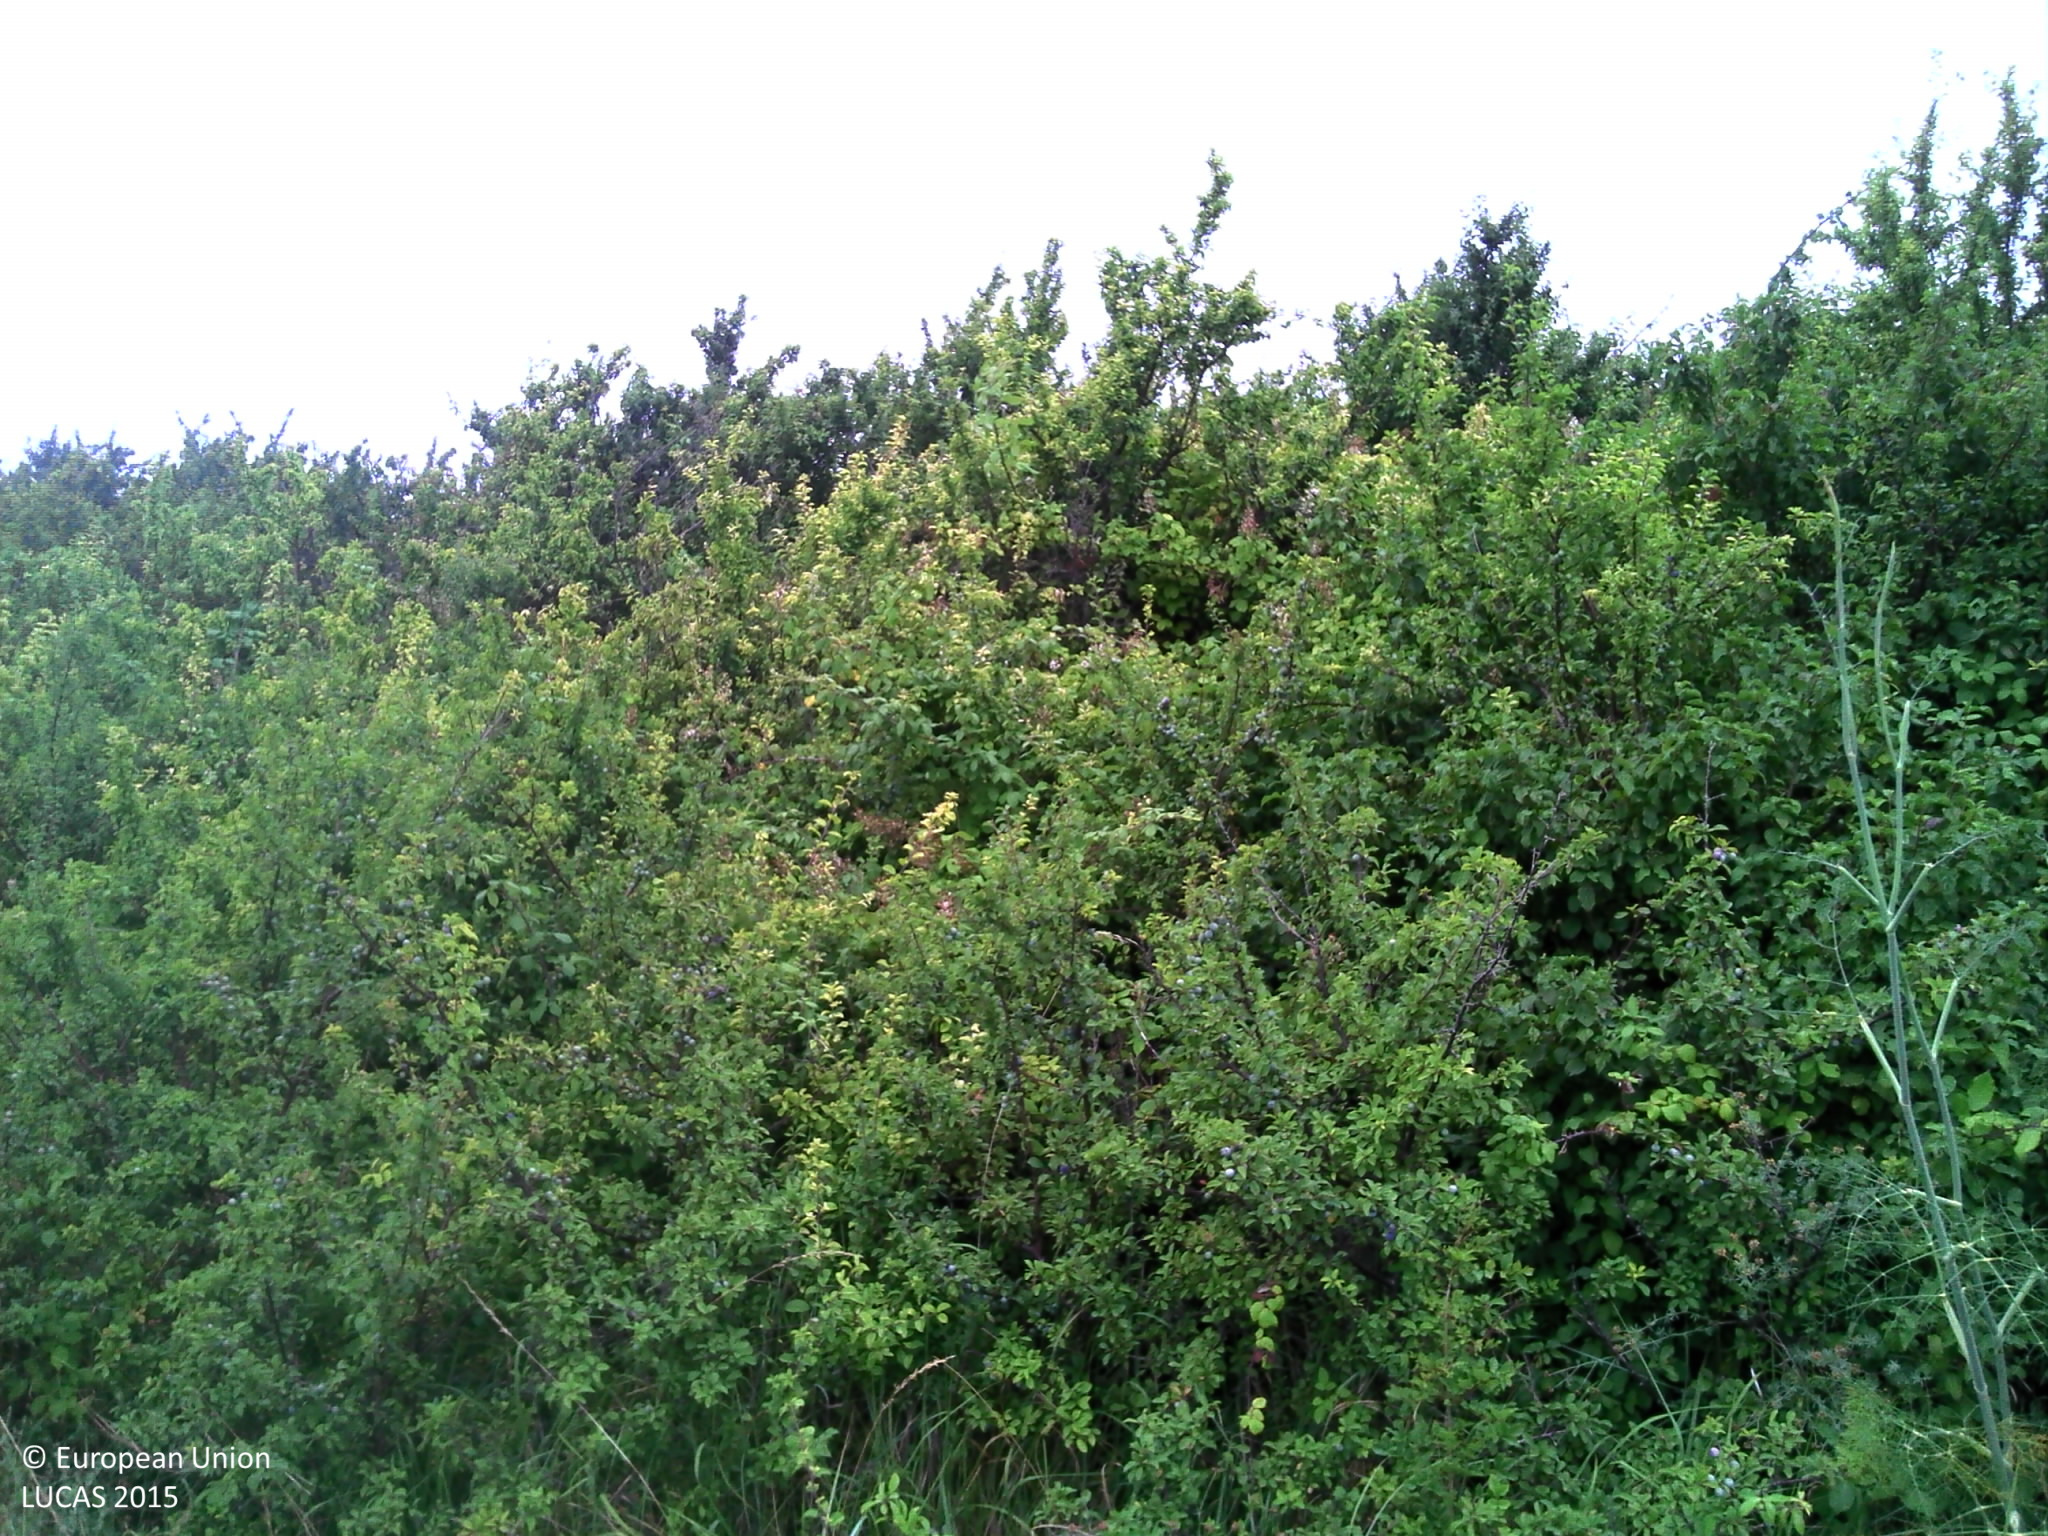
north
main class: Shrubland
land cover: Shrubland without tree cover
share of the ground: > 75 %
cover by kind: shrubs 100 %
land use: Sport
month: July
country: FR
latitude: 45.4775
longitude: -0.7828
